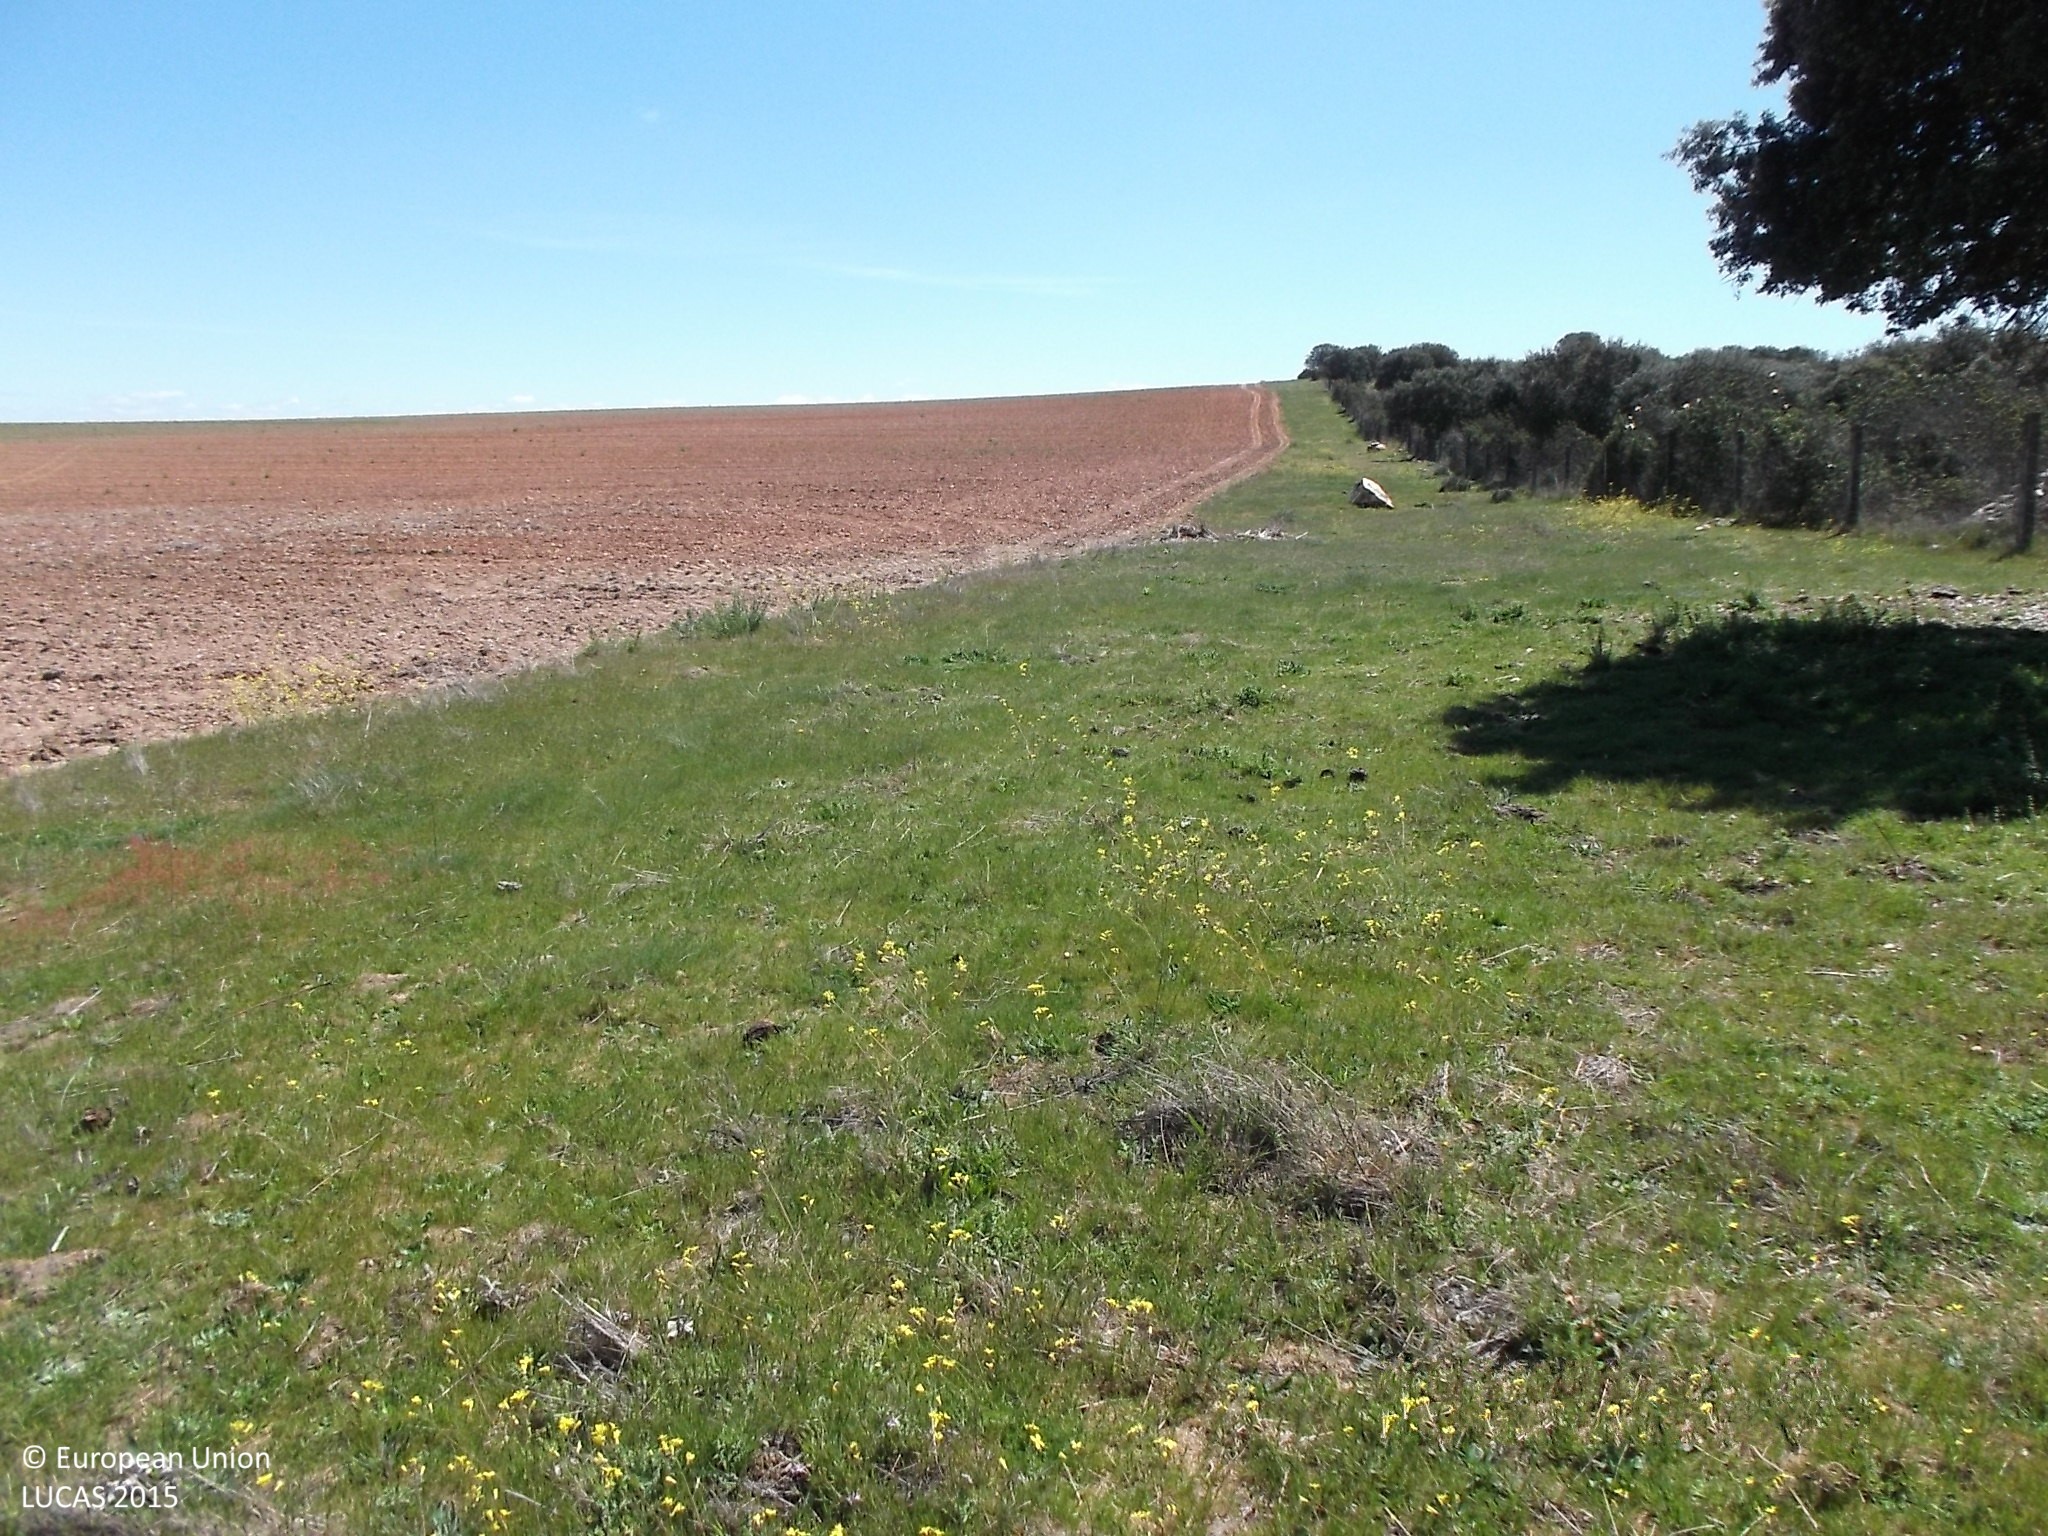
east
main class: Grassland
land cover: Grassland without tree/shrub cover
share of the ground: > 75 %
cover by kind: herbaceous plants 100 %
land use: Agriculture (excluding fallow land and kitchen gardens)
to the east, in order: Grassland without tree/shrub cover
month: April
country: ES
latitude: 41.0370
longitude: -5.9157
